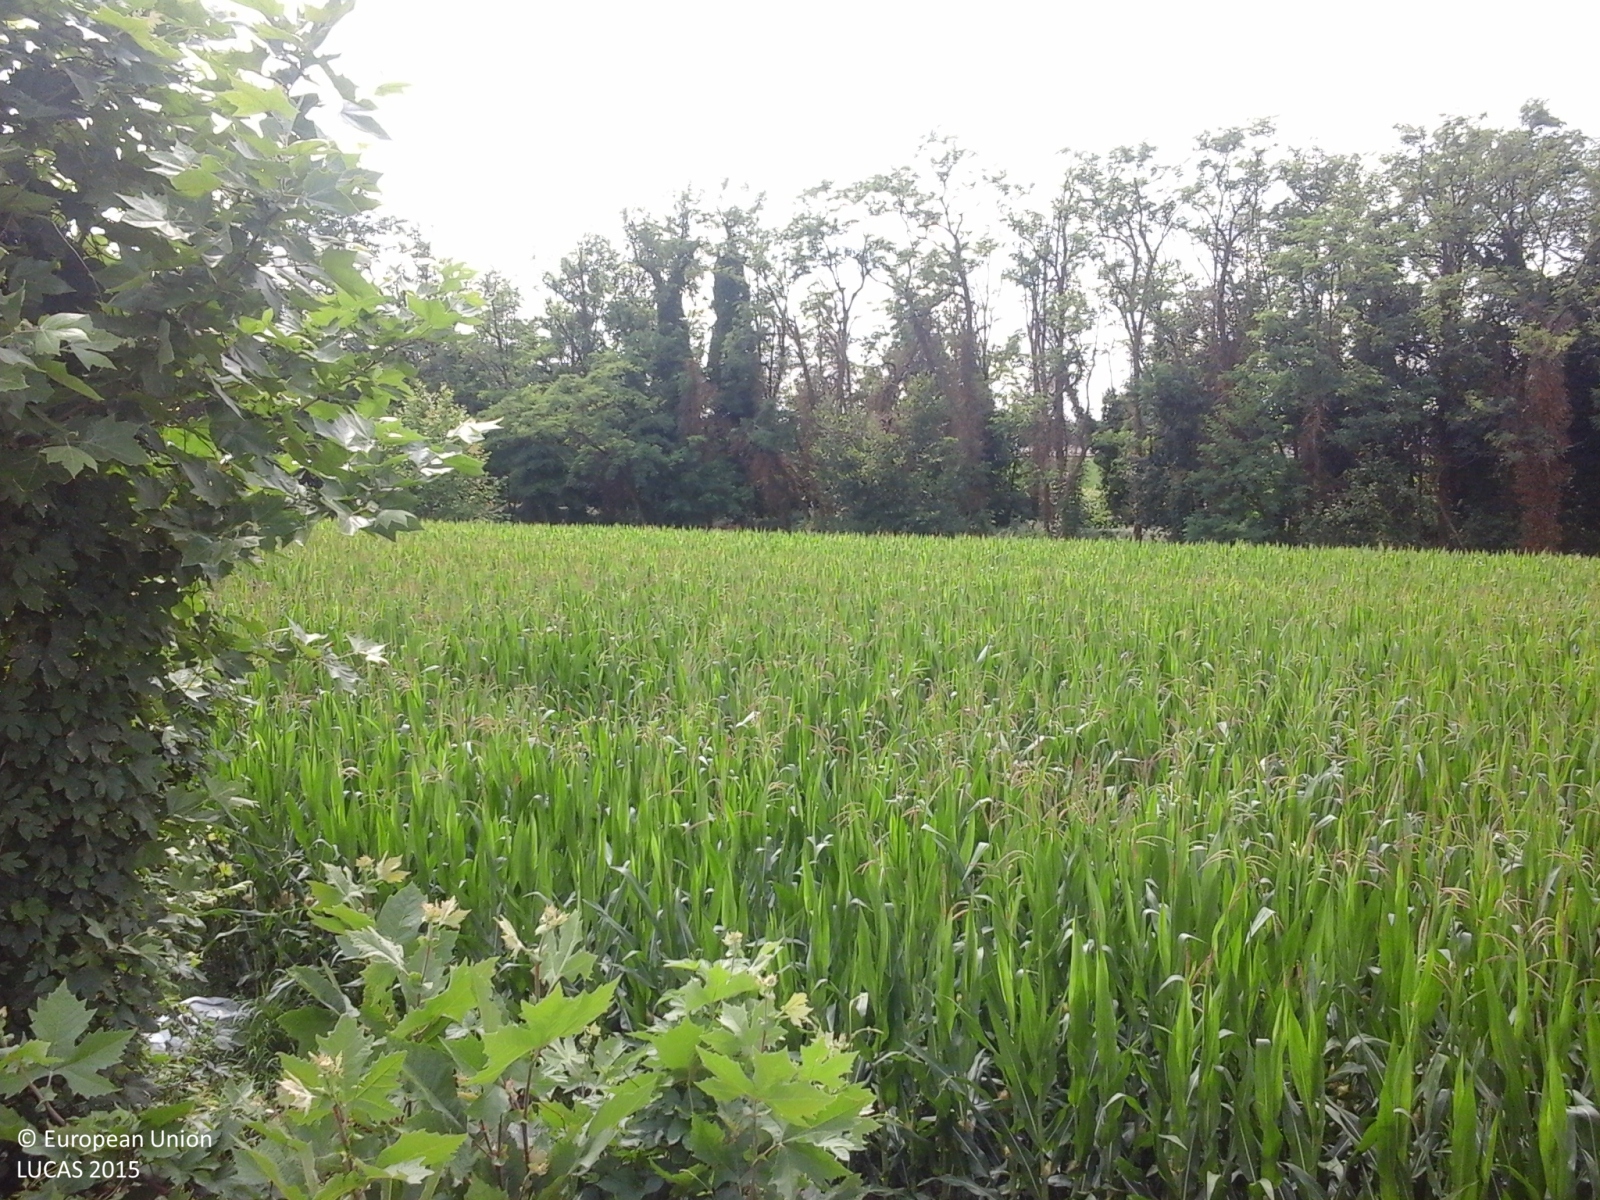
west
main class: Cropland
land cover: Maize
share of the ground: > 75 %
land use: Agriculture (excluding fallow land and kitchen gardens)
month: June
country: IT
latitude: 45.5584
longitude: 9.8593
